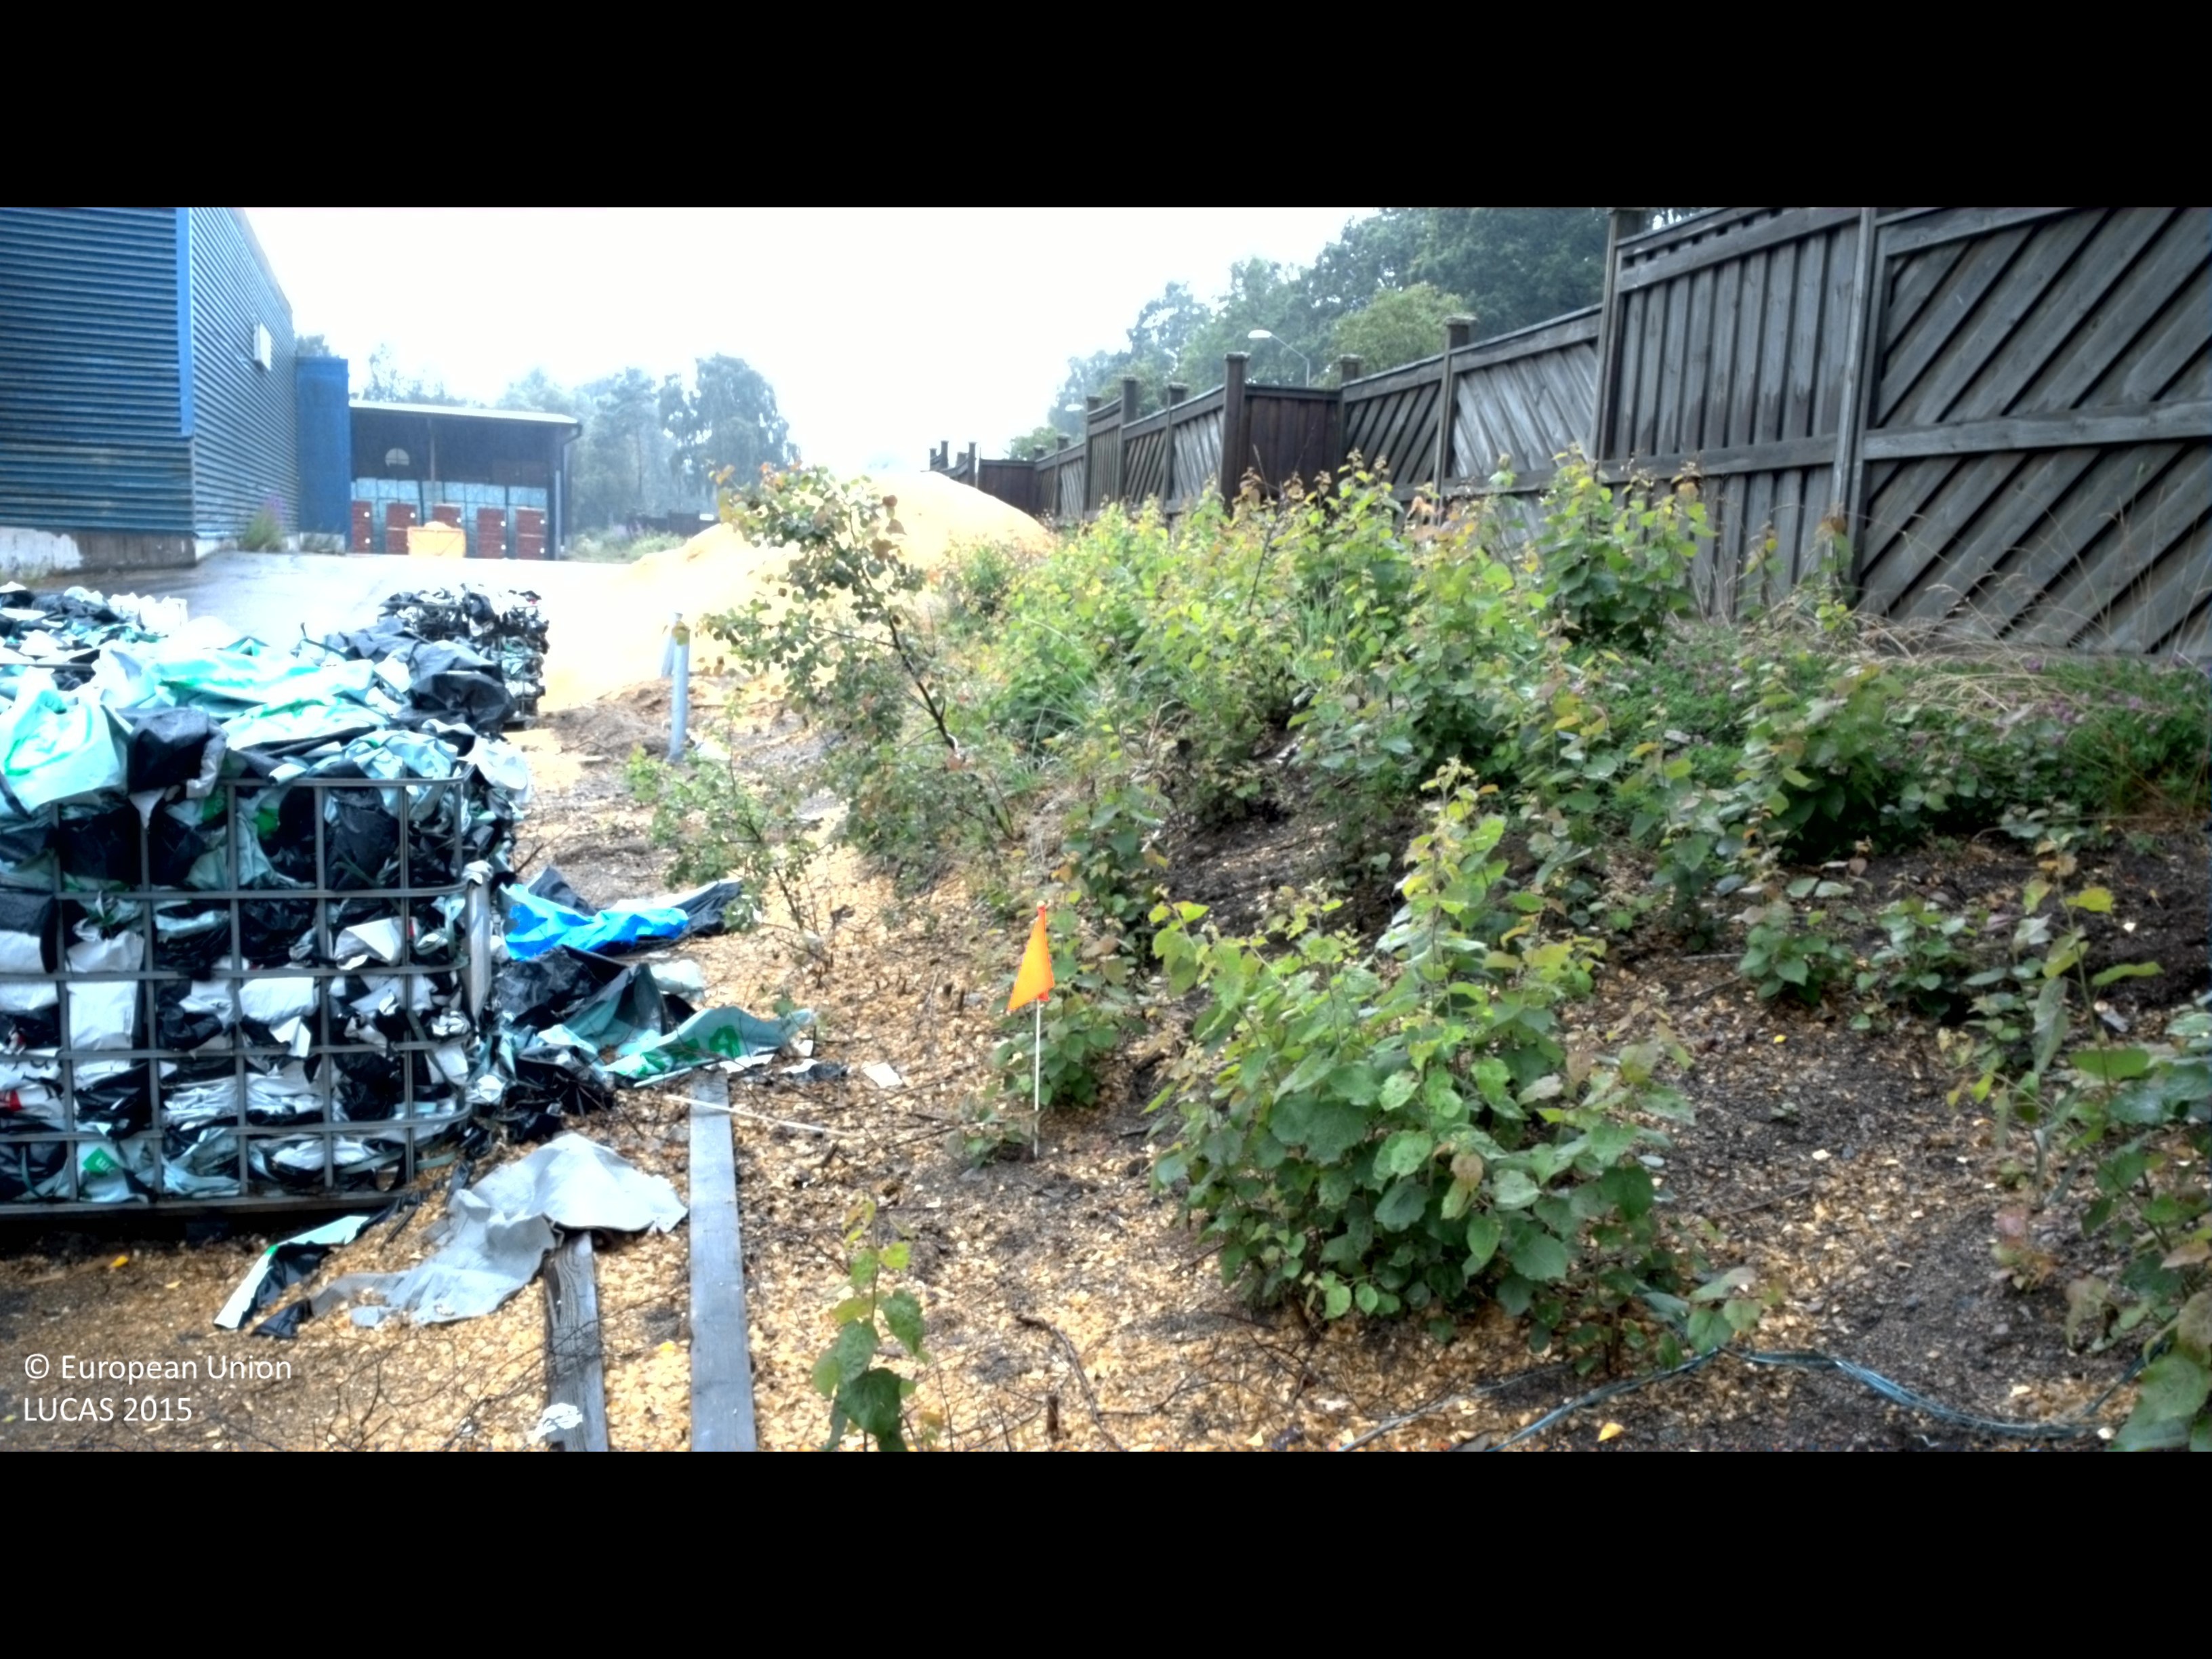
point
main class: Woodland
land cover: Broadleaved woodland
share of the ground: 25 - 50 %
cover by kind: broadleaved forest trees 50 %, herbaceous plants 20 %, lichens and mosses 20 %, unconsolidated bare surface 10 %
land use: Semi-natural and natural areas not in use
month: July
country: SE
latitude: 56.5828
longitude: 13.7578
